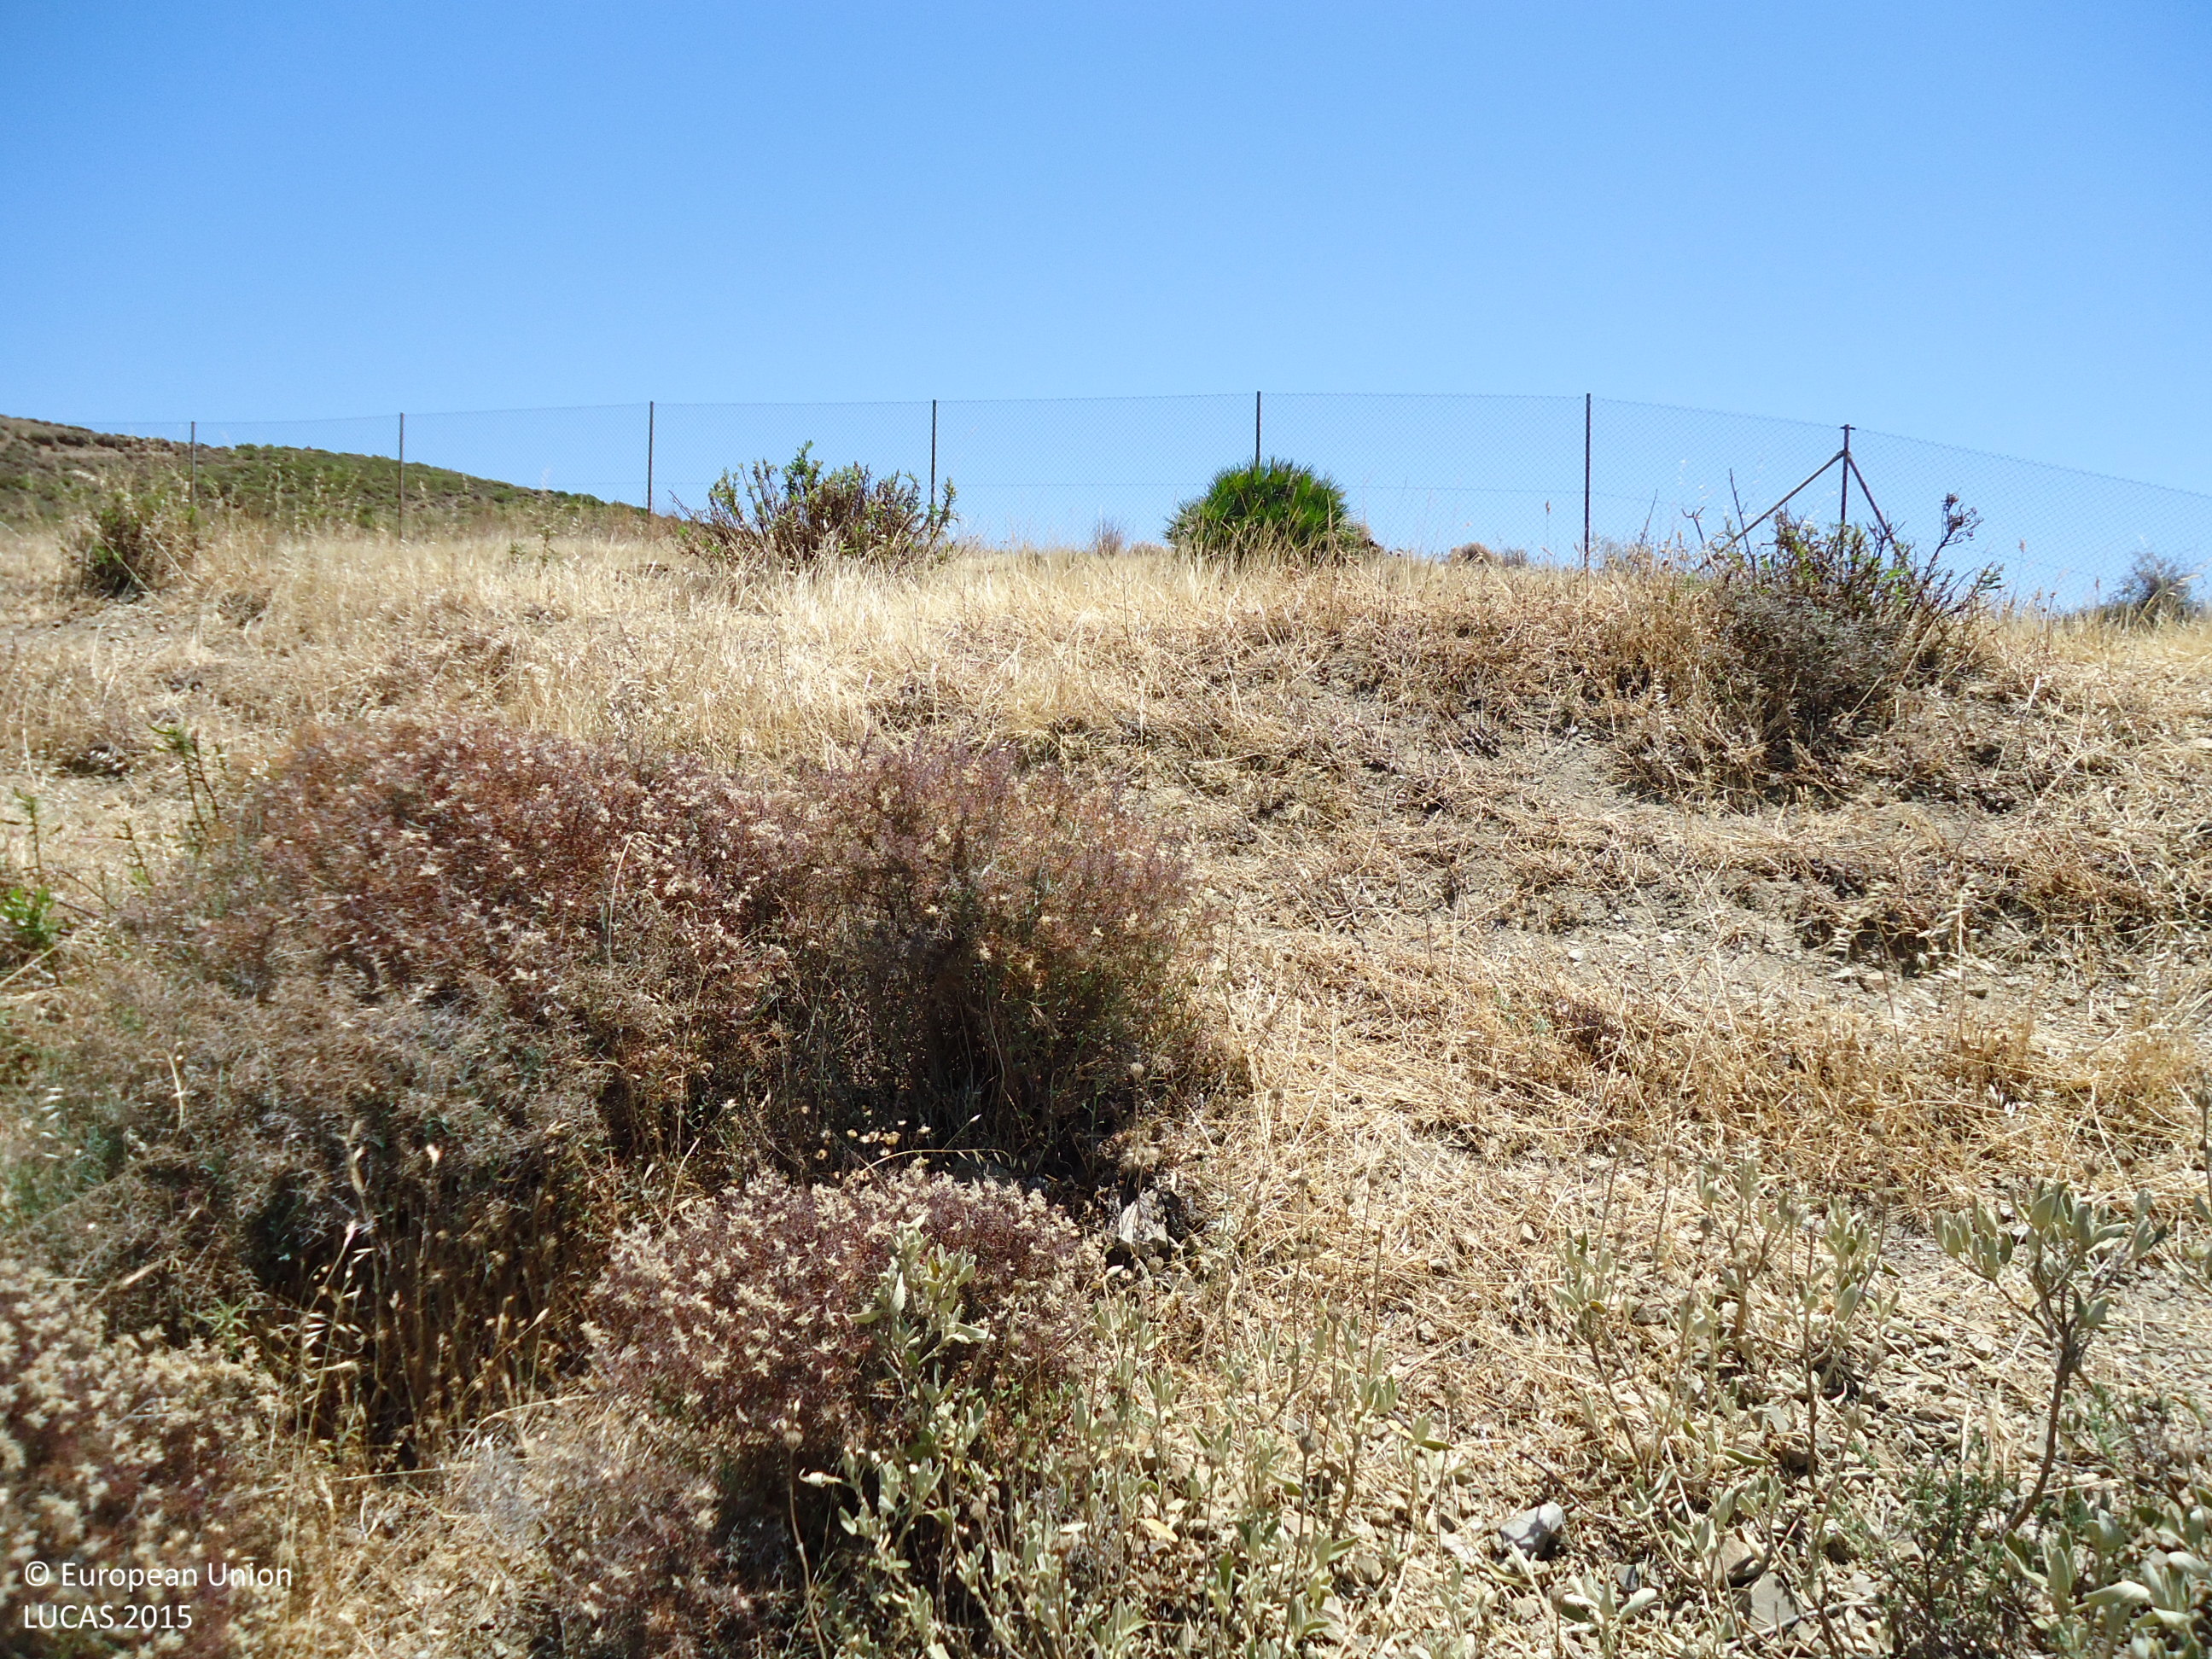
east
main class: Woodland
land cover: Broadleaved woodland
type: broadleaved evergreen forest
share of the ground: > 75 %
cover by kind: shrubs 80 %, broadleaved forest trees 20 %
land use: Semi-natural and natural areas not in use
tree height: < 5 m
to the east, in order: Broadleaved woodland; Shrubland without tree cover; Tracks; Grass margins; Fences; Other bare soil
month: June
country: ES
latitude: 36.4478
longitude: -5.1783
